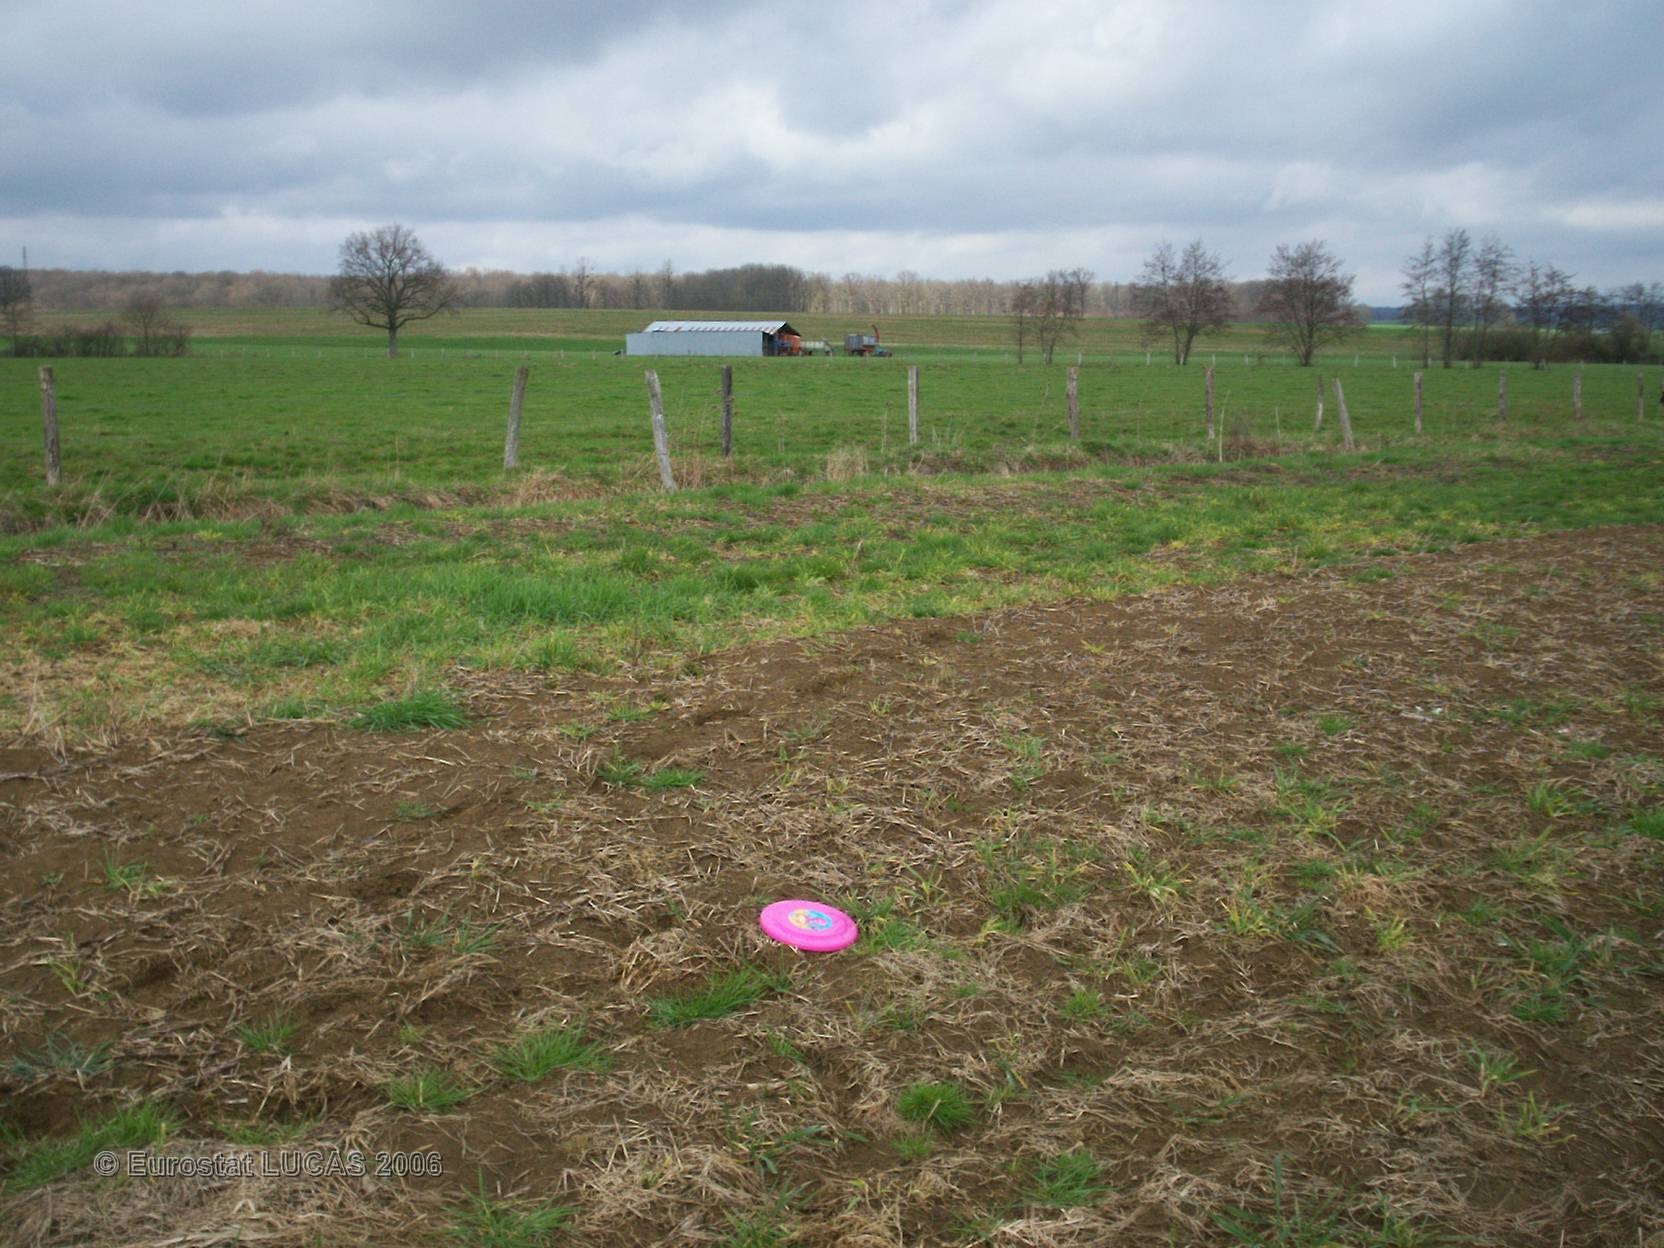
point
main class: Cropland
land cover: Maize
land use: Agriculture (excluding fallow land and kitchen gardens)
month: May
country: FR
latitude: 47.6233
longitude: 6.3688
